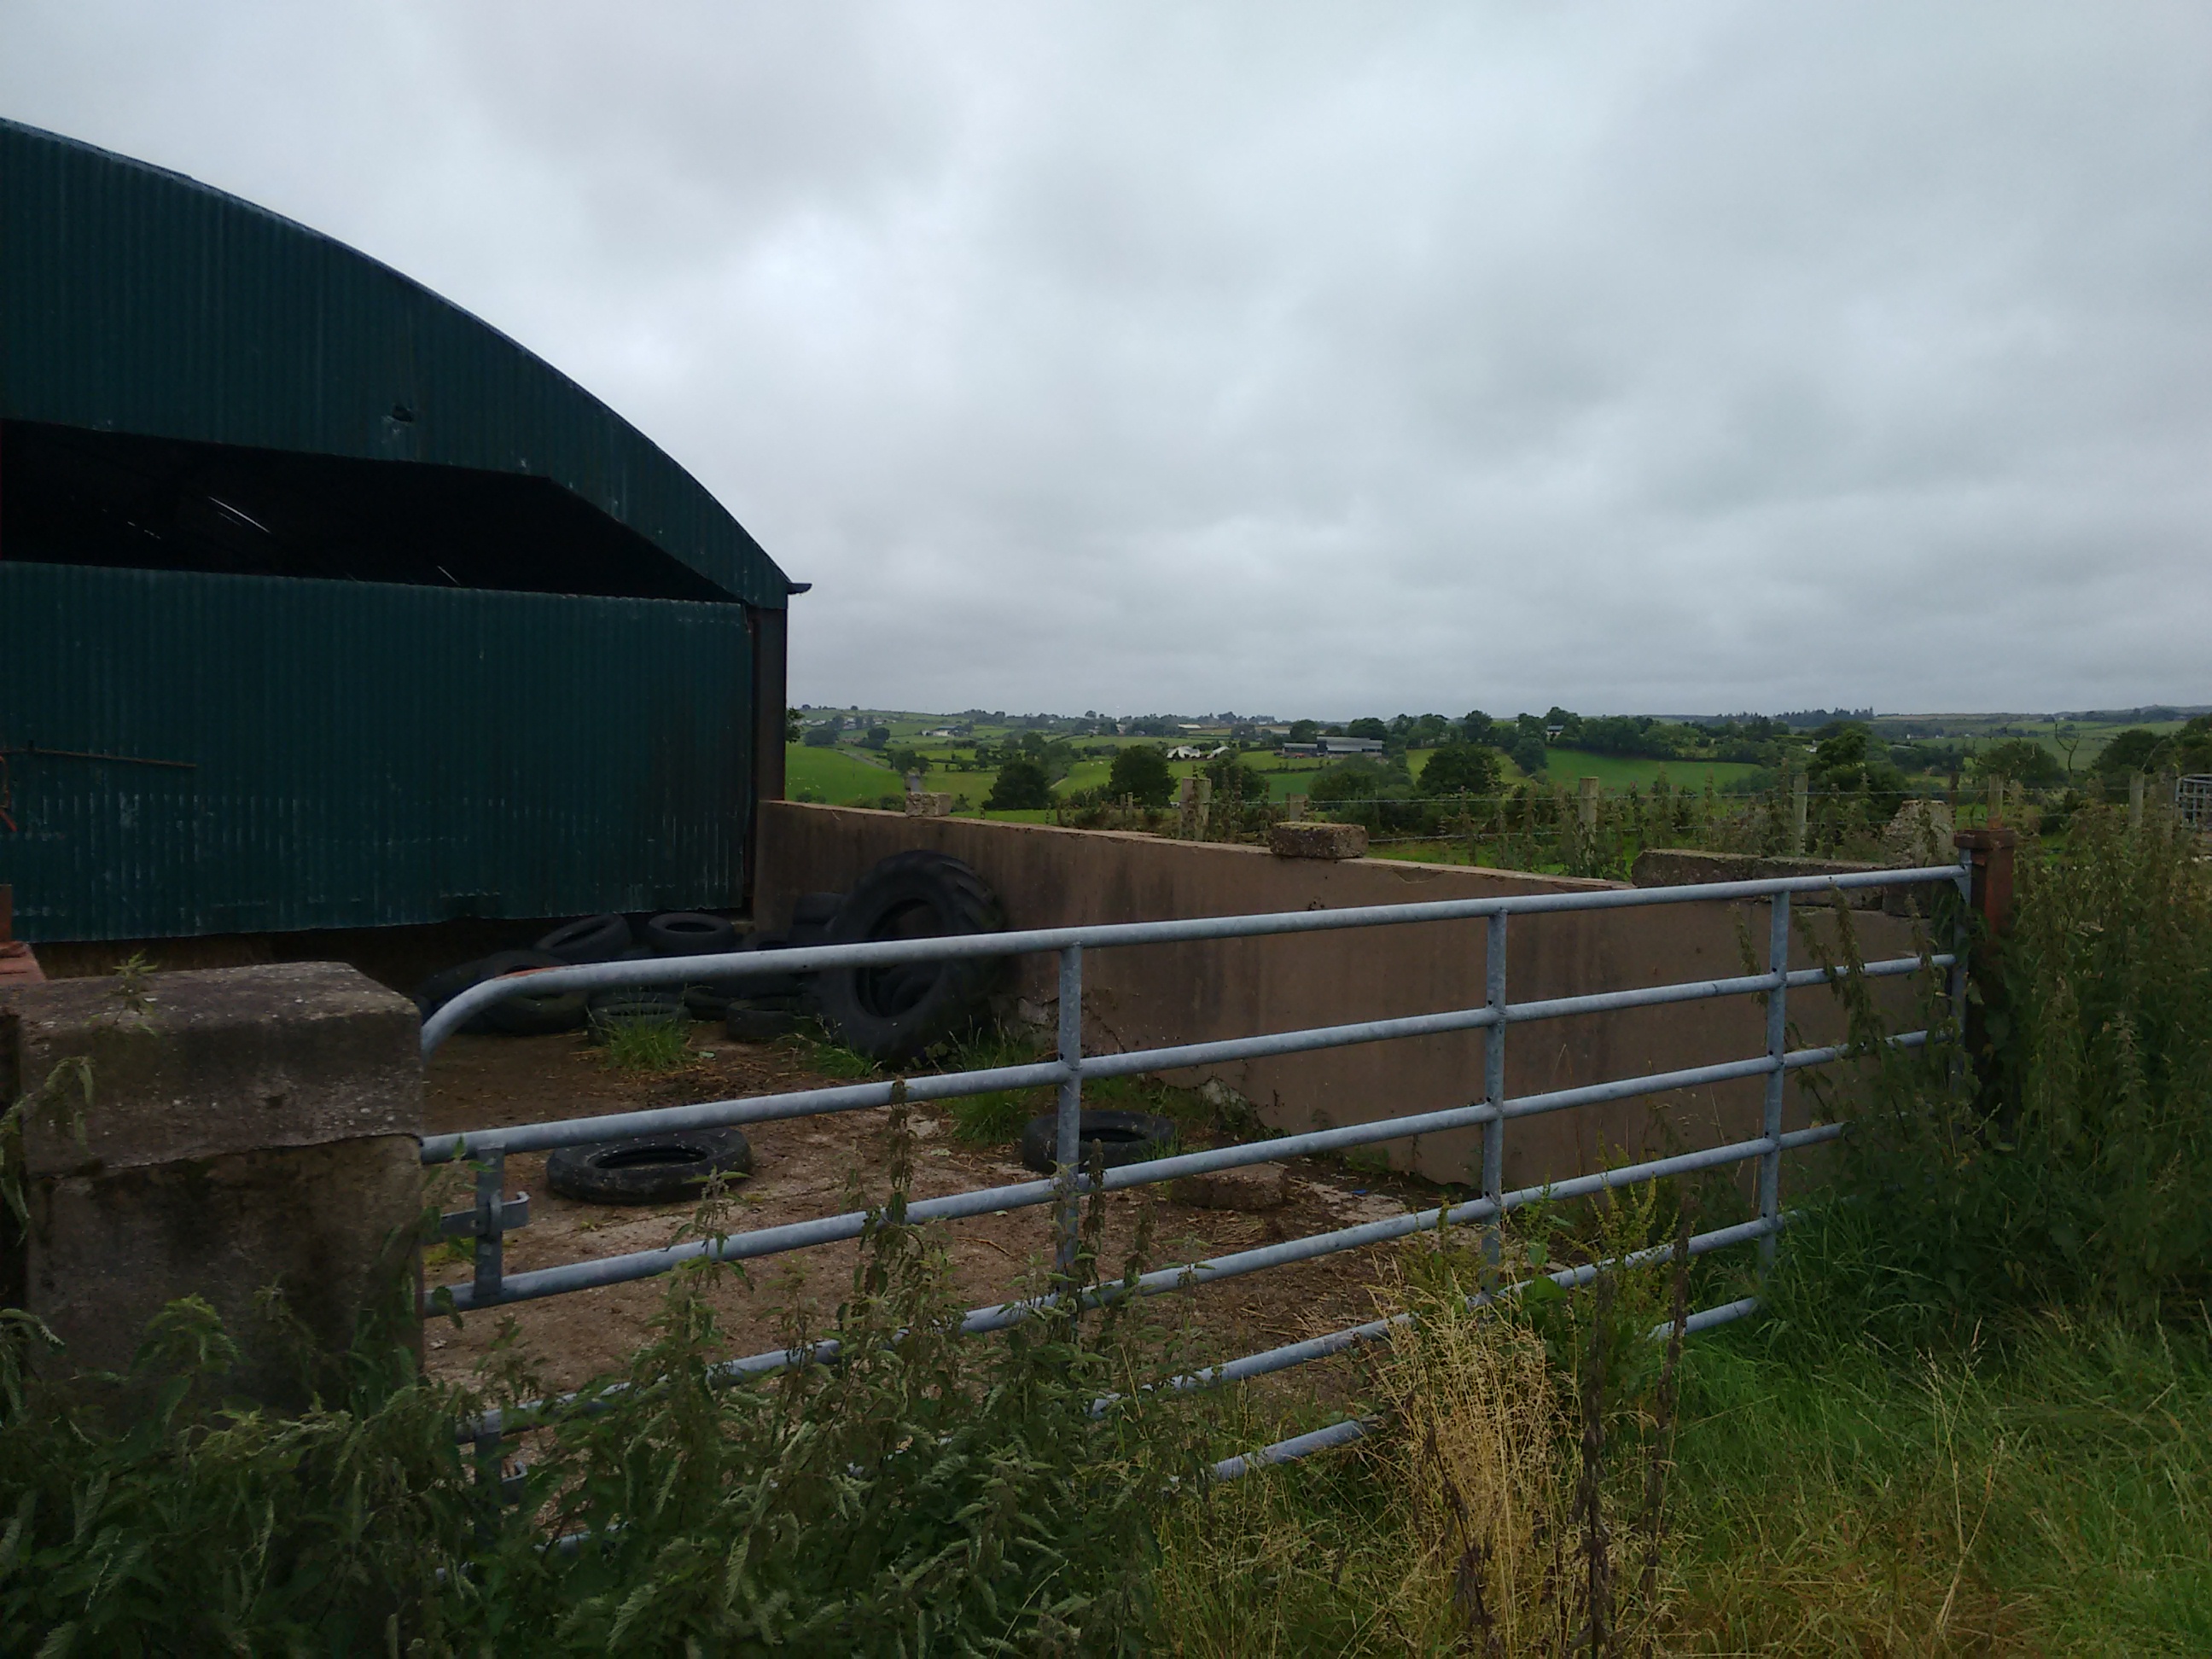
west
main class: Grassland
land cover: Grassland without tree/shrub cover
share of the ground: > 75 %
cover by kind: herbaceous plants 100 %
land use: Agriculture (excluding fallow land and kitchen gardens)
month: August
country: GB
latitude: 54.6115
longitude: -6.9050
